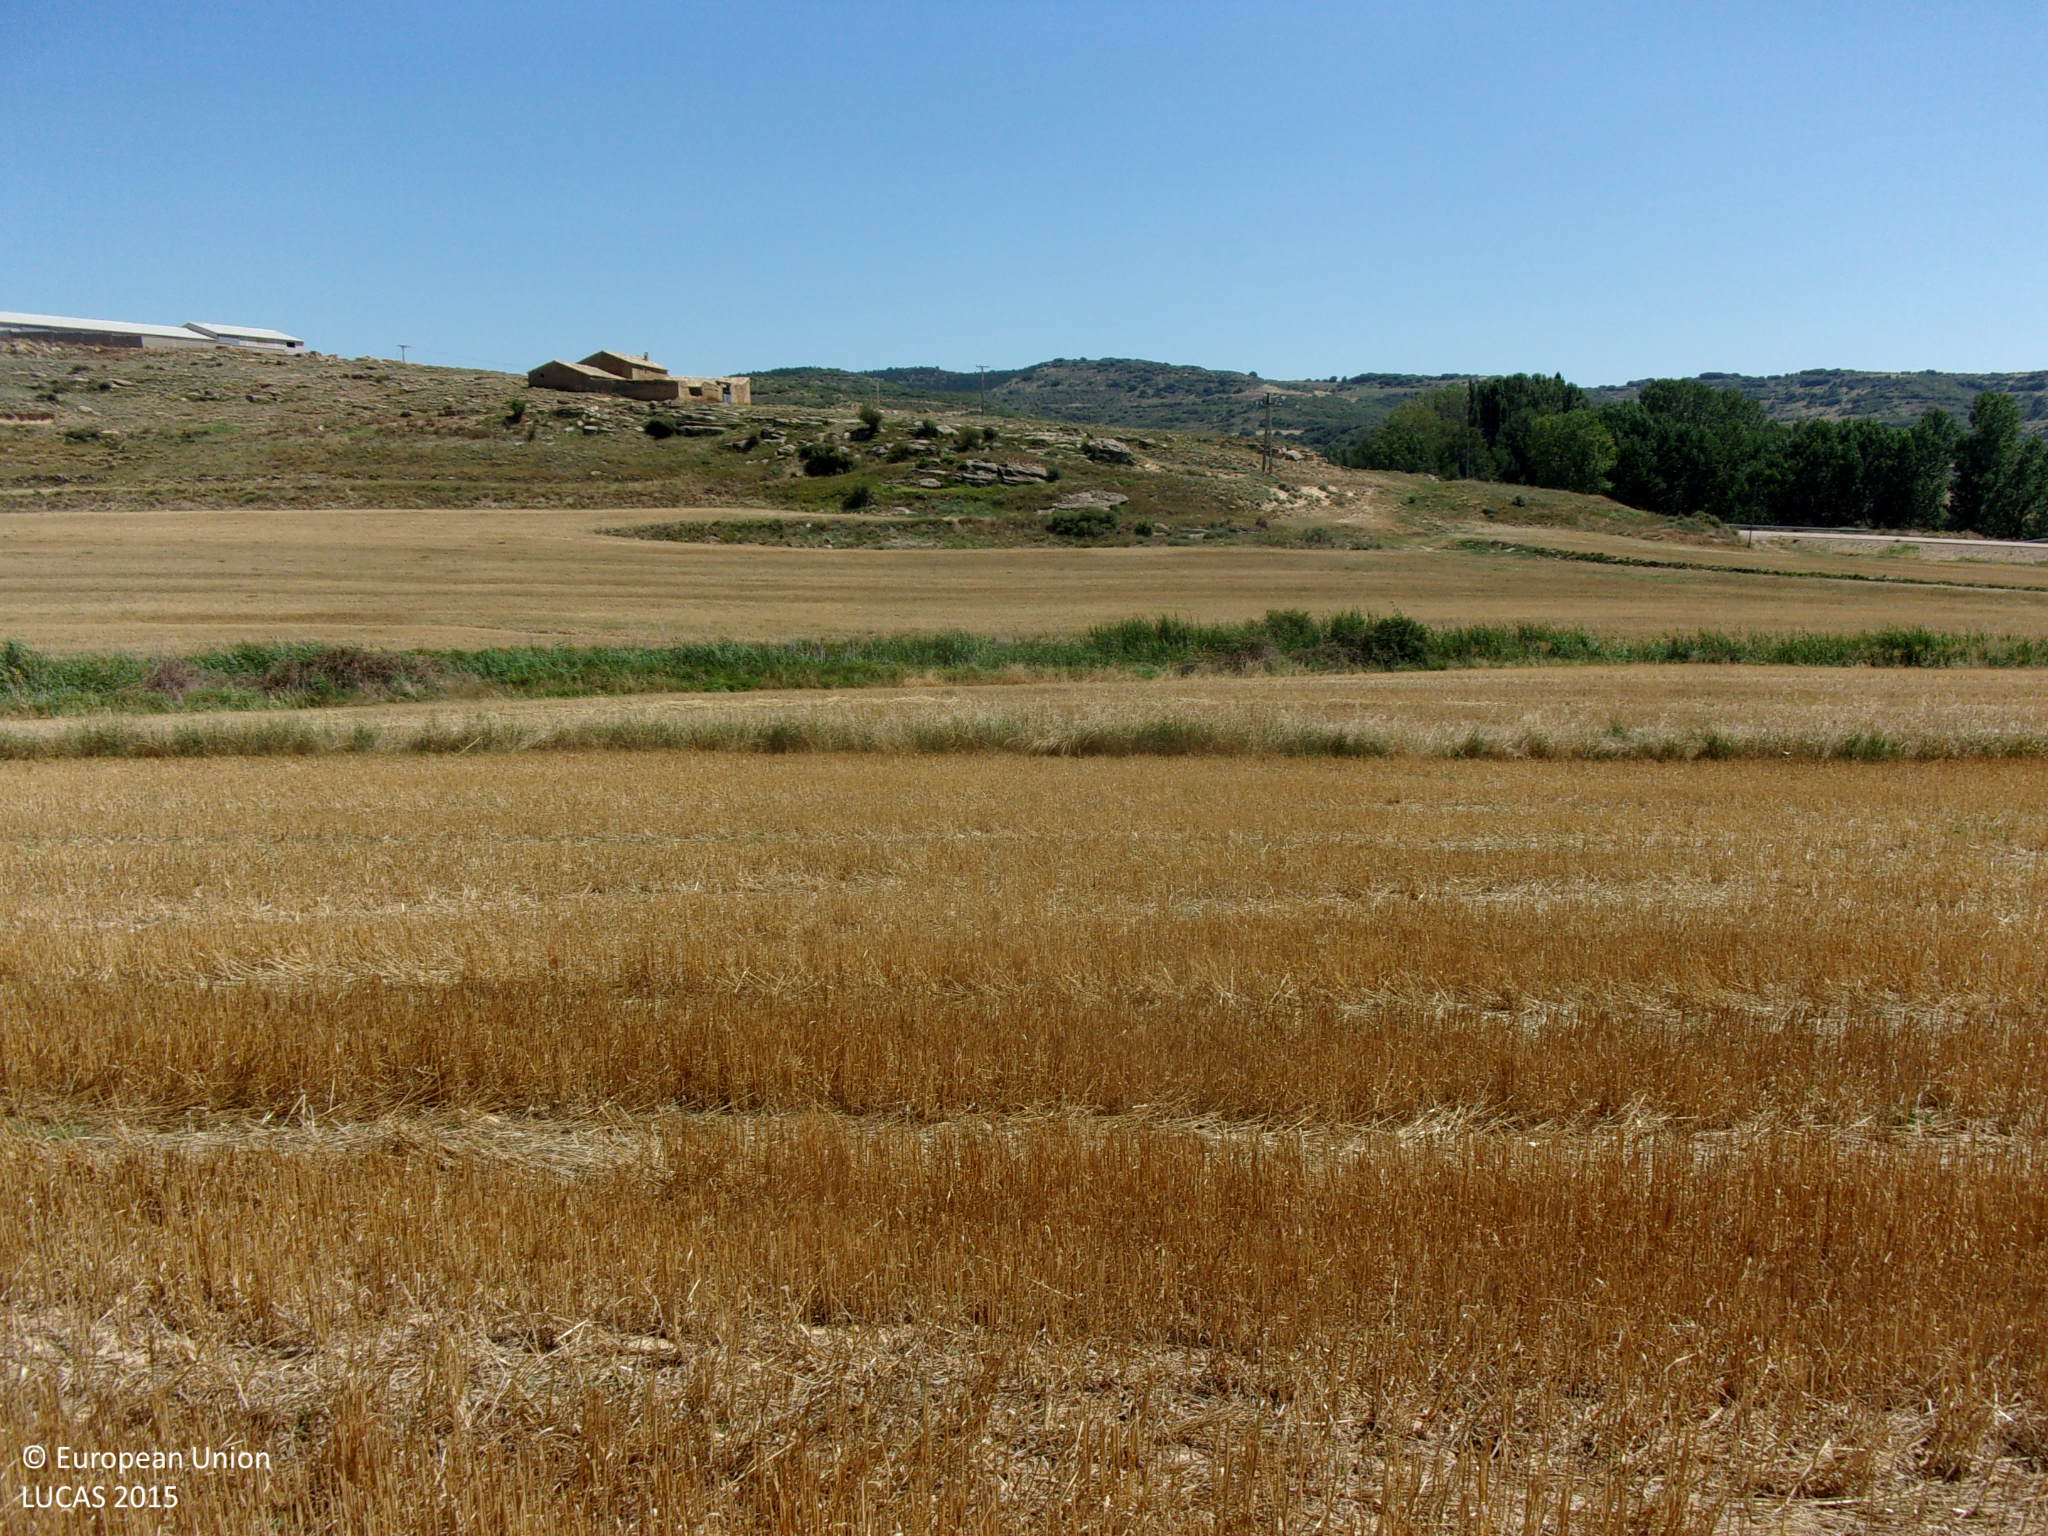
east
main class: Cropland
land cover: Common wheat
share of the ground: < 10 %
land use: Agriculture (excluding fallow land and kitchen gardens)
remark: Harvested field
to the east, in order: Common wheat; Grass margins; Common wheat; Shruby margins; Rivers and streams; Shruby margins; Common wheat; Grassland without tree/shrub cover; Electric lines; Grassland without tree/shrub cover
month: August
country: ES
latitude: 42.3448
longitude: -1.1614
